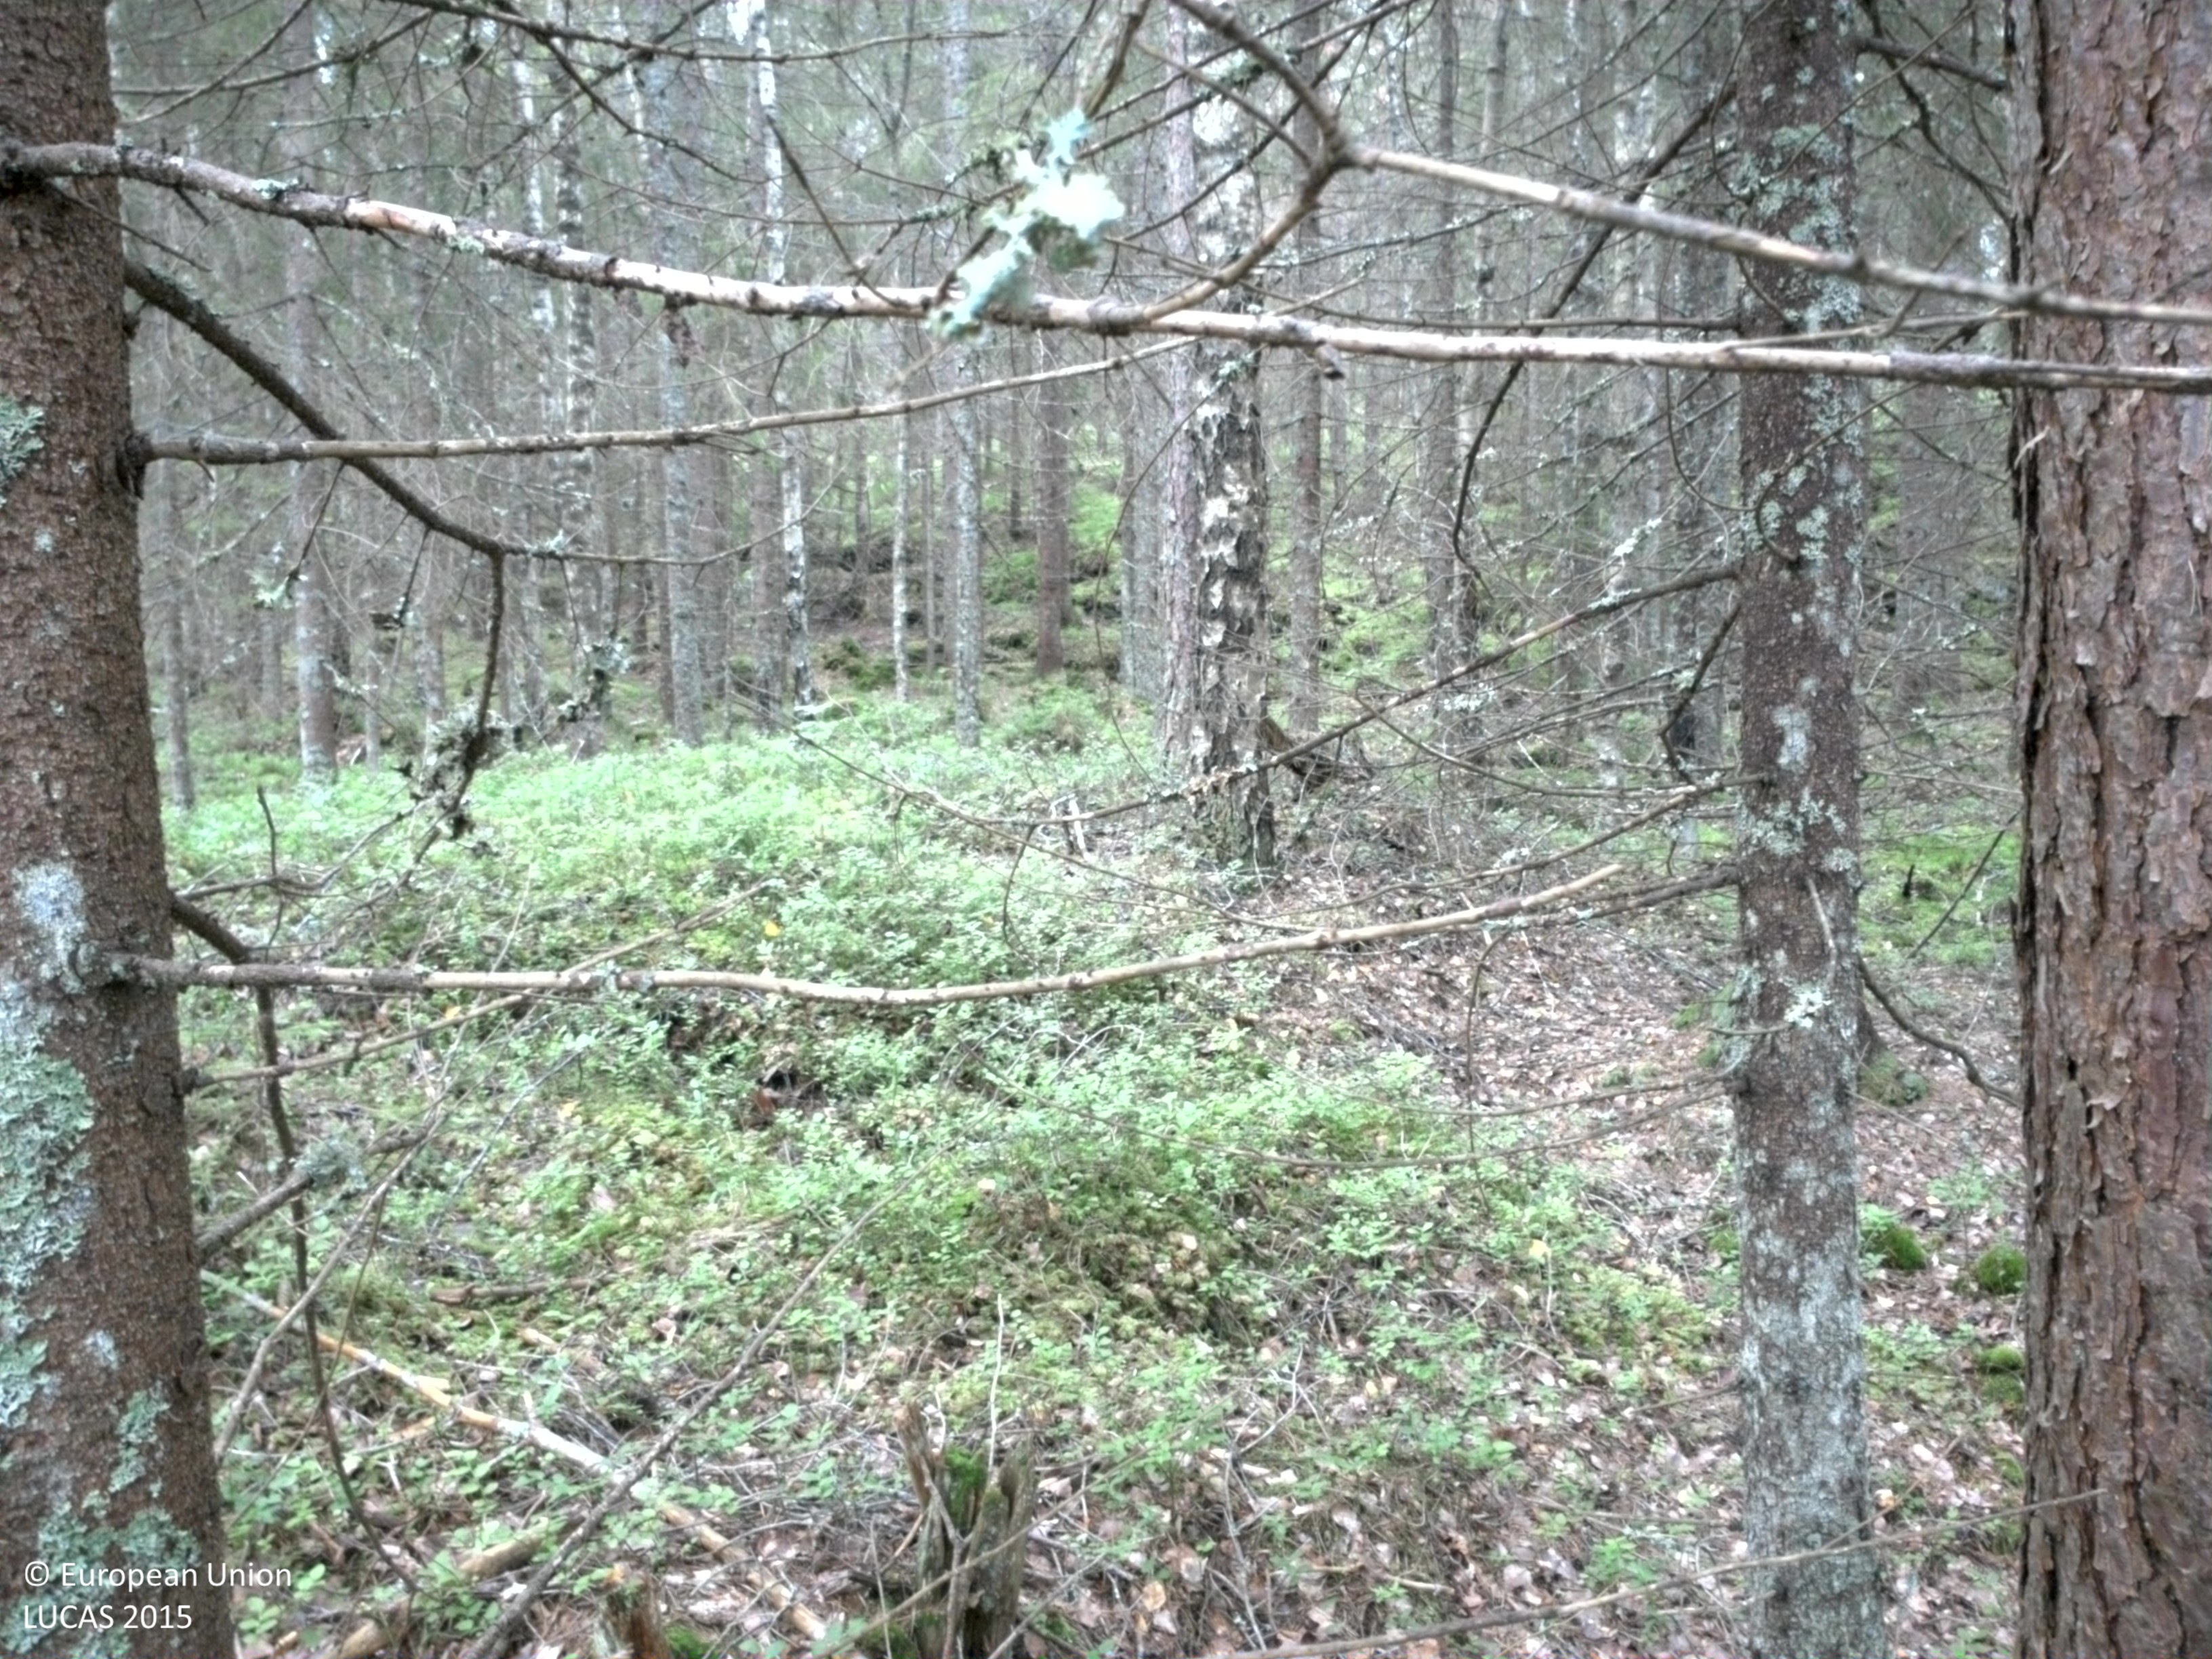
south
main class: Woodland
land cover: Spruce dominated coniferous woodland
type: boreal forest
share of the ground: 50 - 75 %
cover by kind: coniferous forest trees 65 %, lichens and mosses 20 %, shrubs 10 %, broadleaved forest trees 5 %
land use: Forestry
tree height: > 5 m
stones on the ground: < 10 %
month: August
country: SE
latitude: 59.2501
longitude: 11.8715
